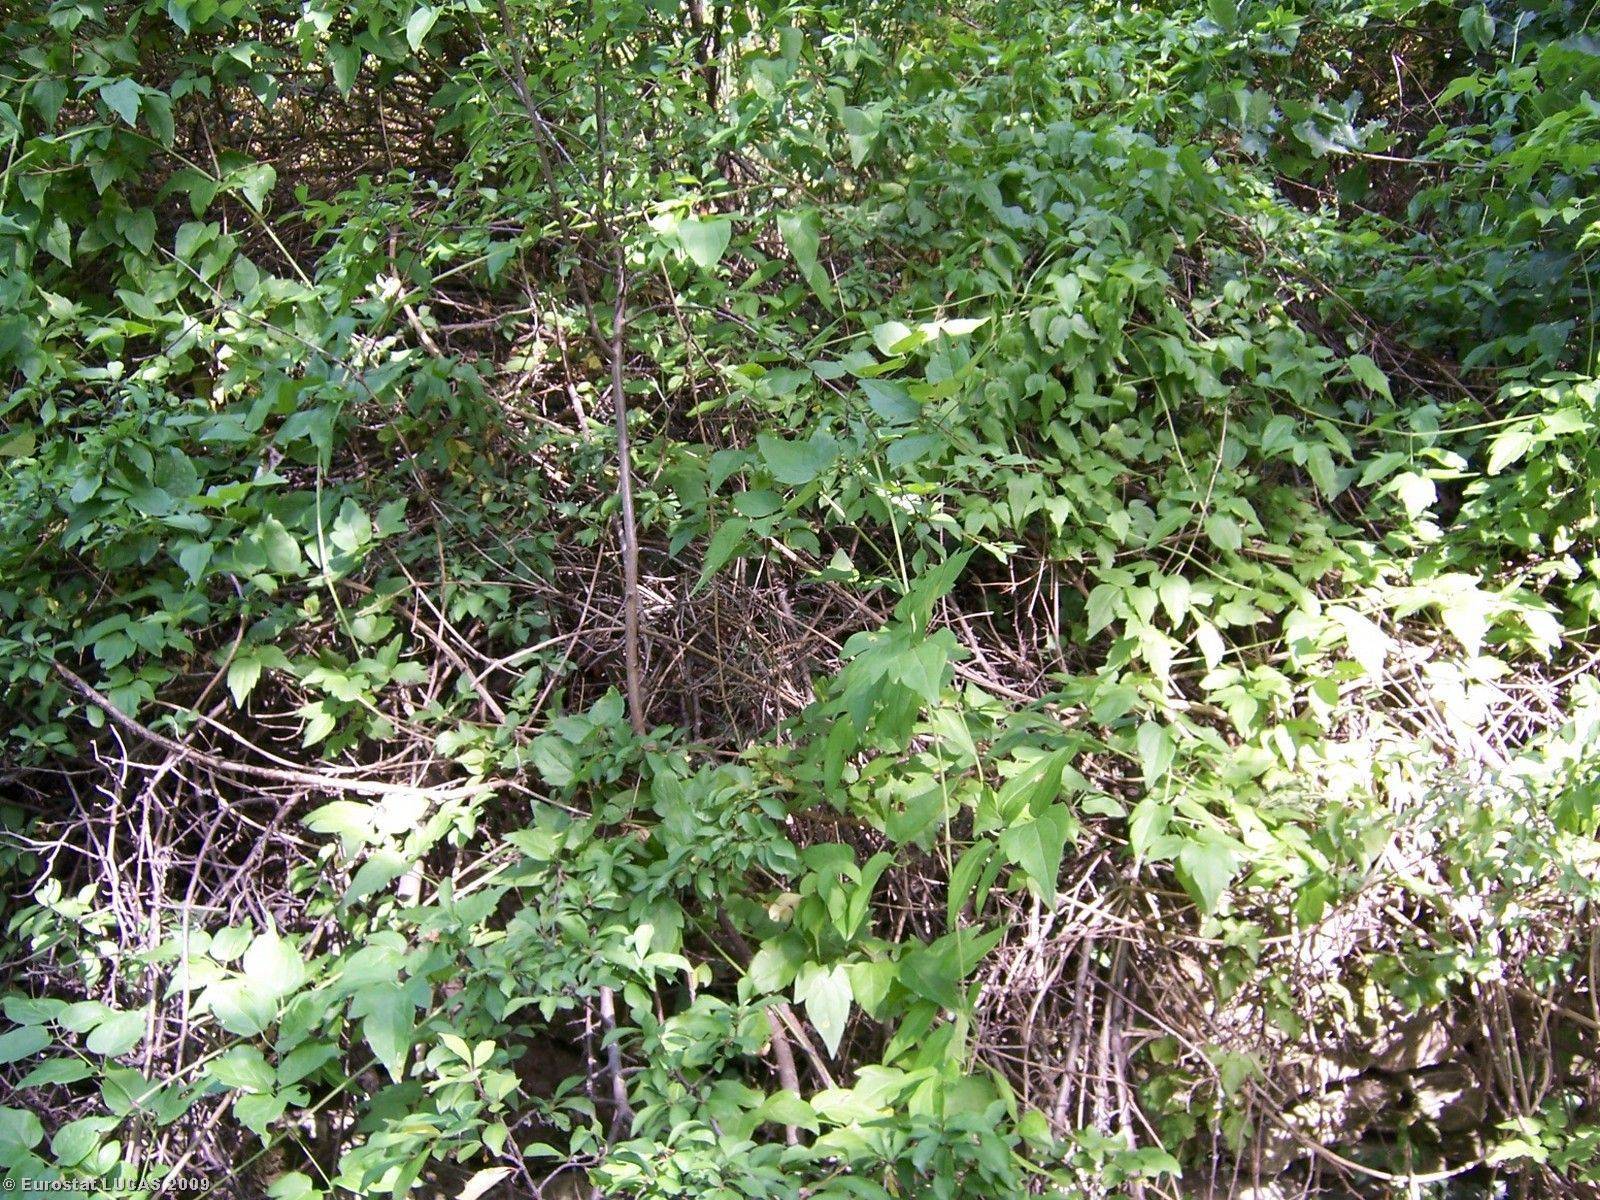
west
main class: Woodland
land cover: Broadleaved woodland
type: mesophytic deciduous forest
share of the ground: > 75 %
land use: Unused
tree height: > 5 m
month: July
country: IT
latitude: 45.1218
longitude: 7.0935
